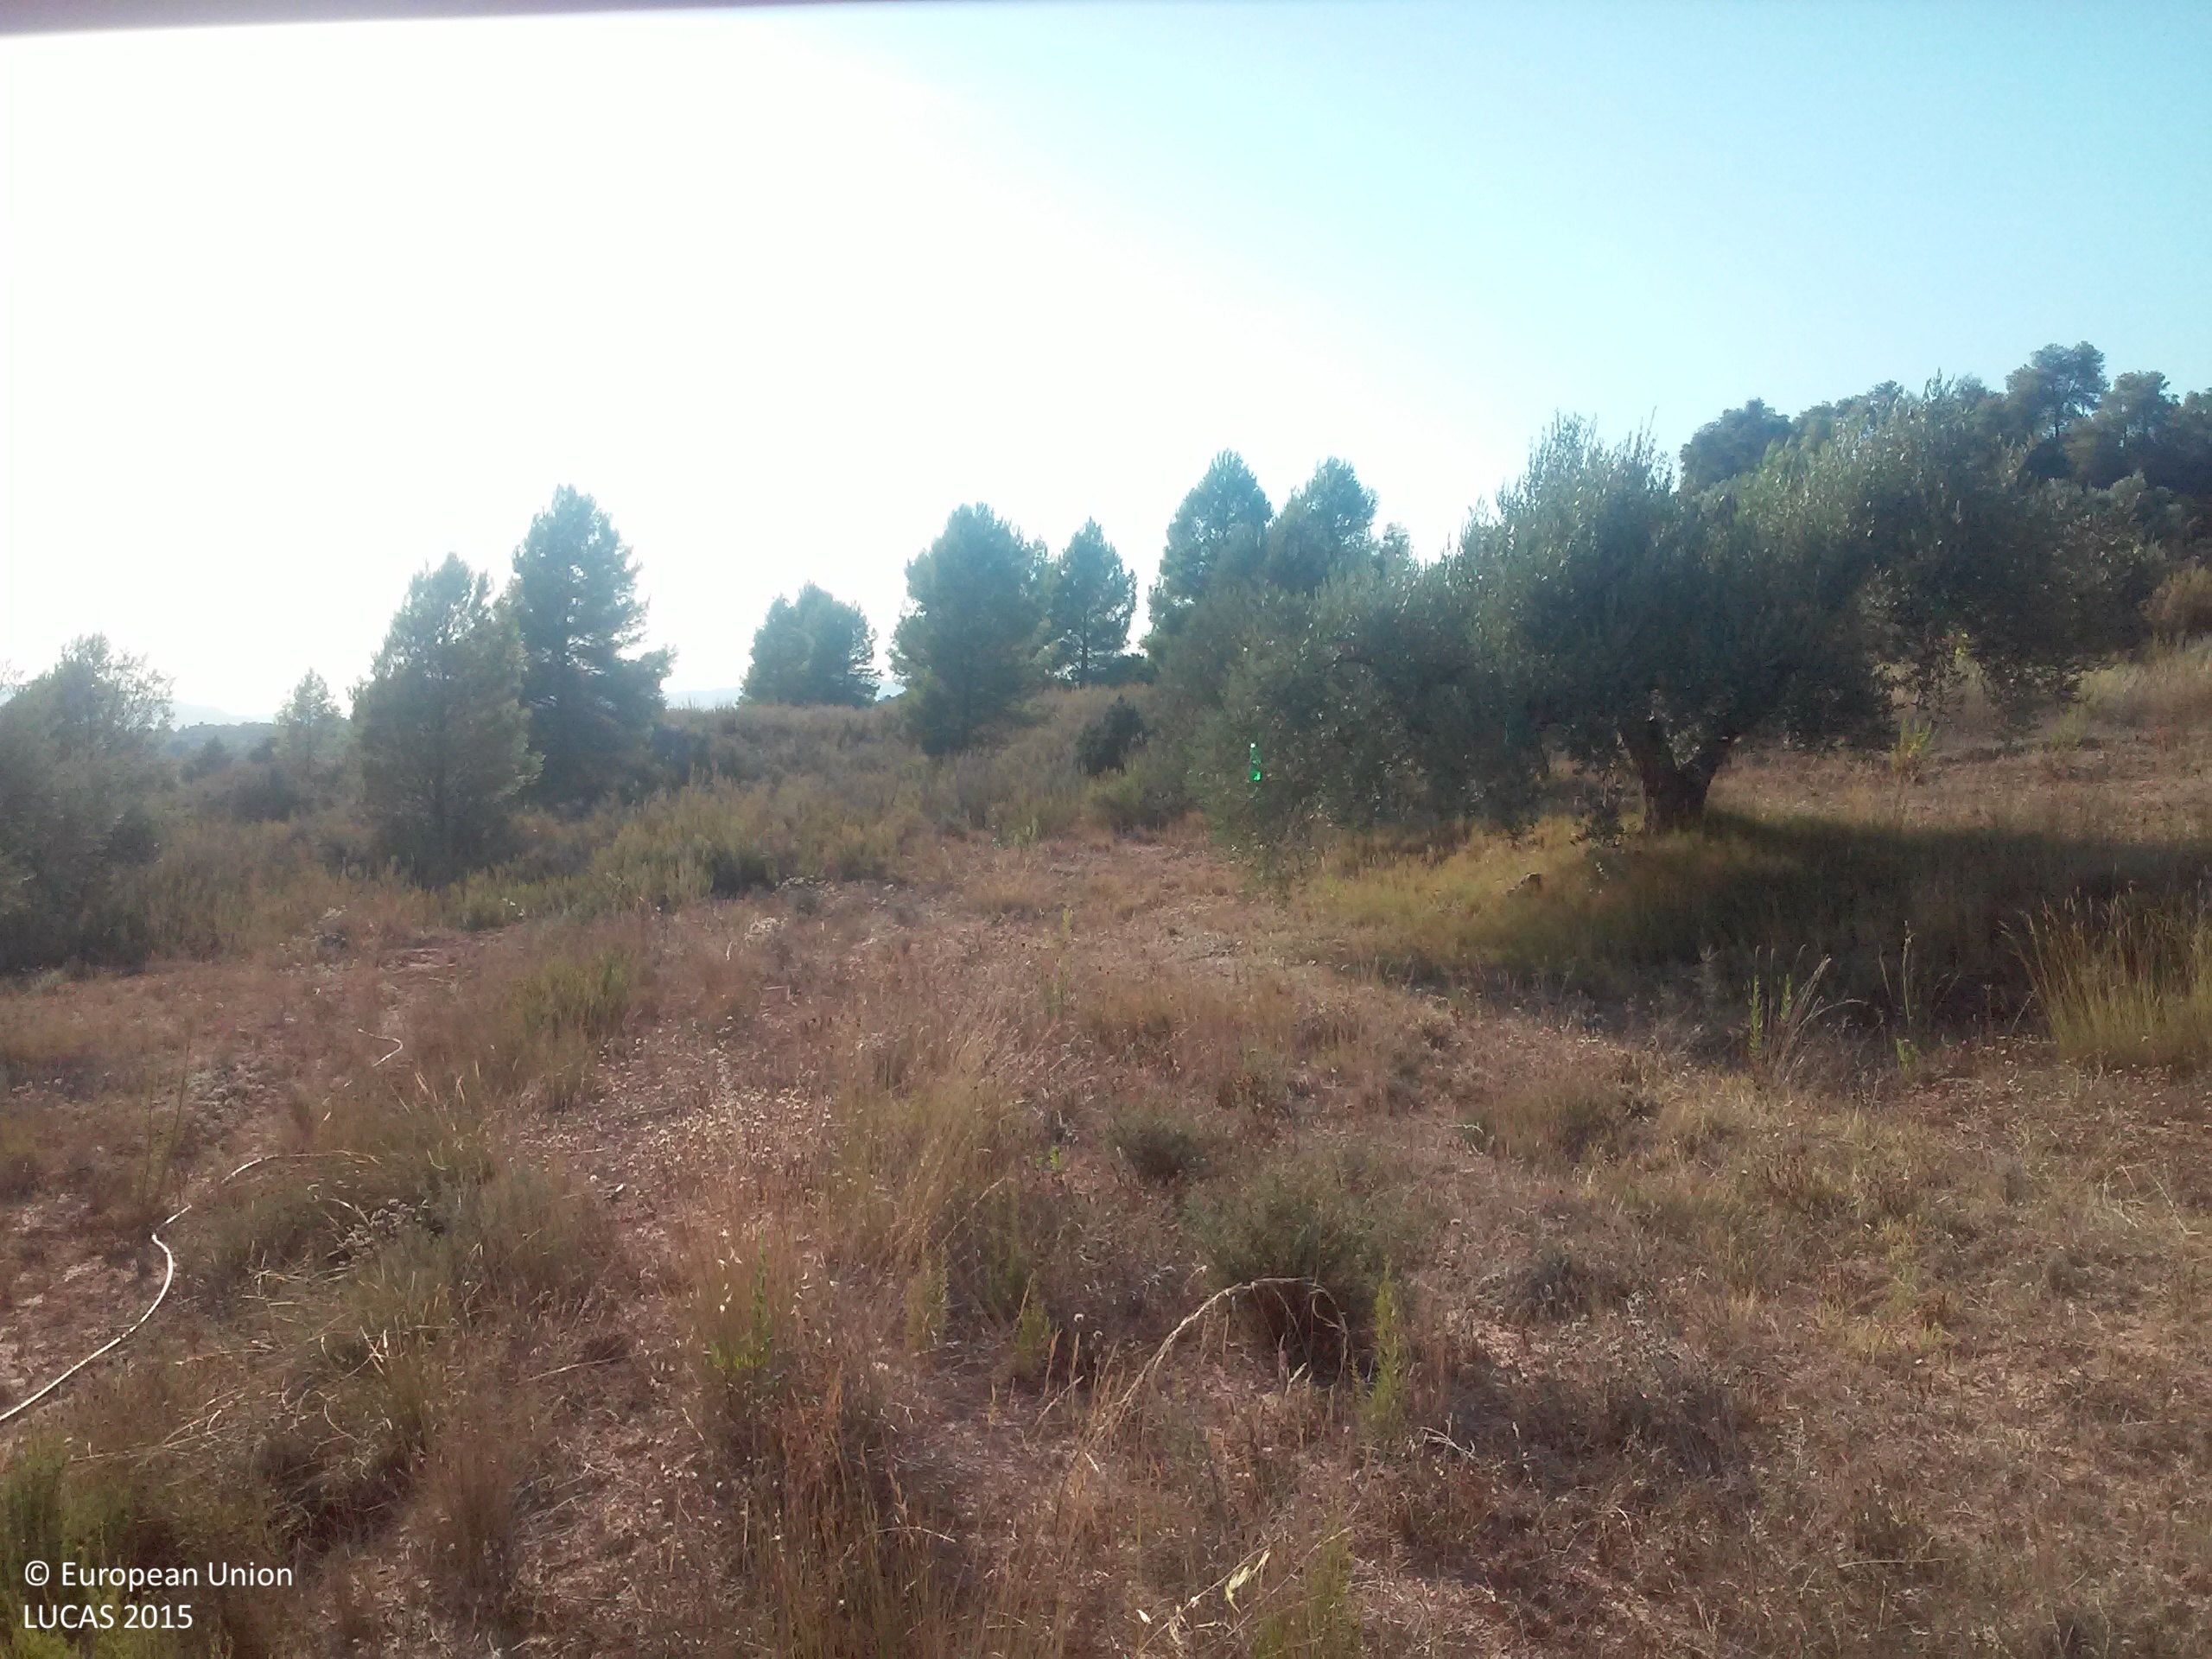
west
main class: Cropland
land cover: Olive groves
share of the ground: 10 - 25 %
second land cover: Grassland without tree/shrub cover
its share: > 75 %
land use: Agriculture (excluding fallow land and kitchen gardens)
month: August
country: ES
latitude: 41.2524
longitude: 0.5983
